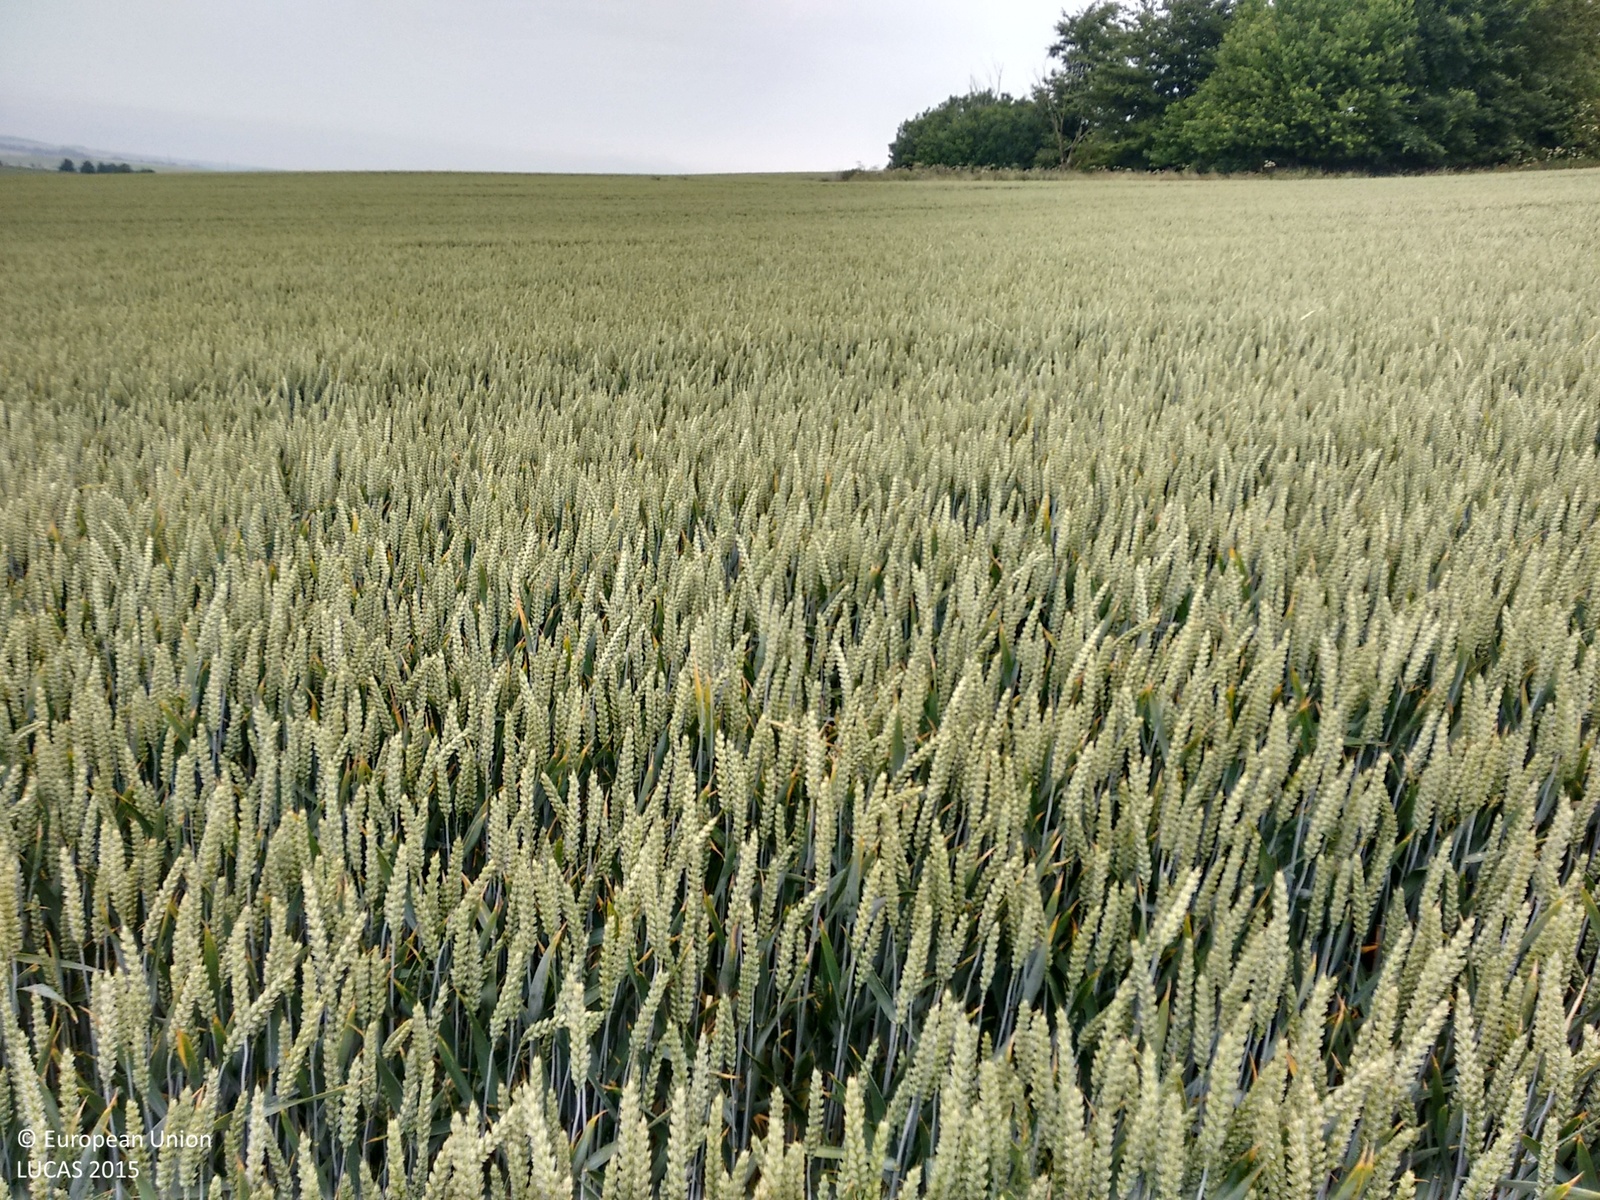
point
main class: Cropland
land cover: Common wheat
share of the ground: > 75 %
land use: Agriculture (excluding fallow land and kitchen gardens)
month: July
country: GB
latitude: 51.5487
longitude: -1.0775
